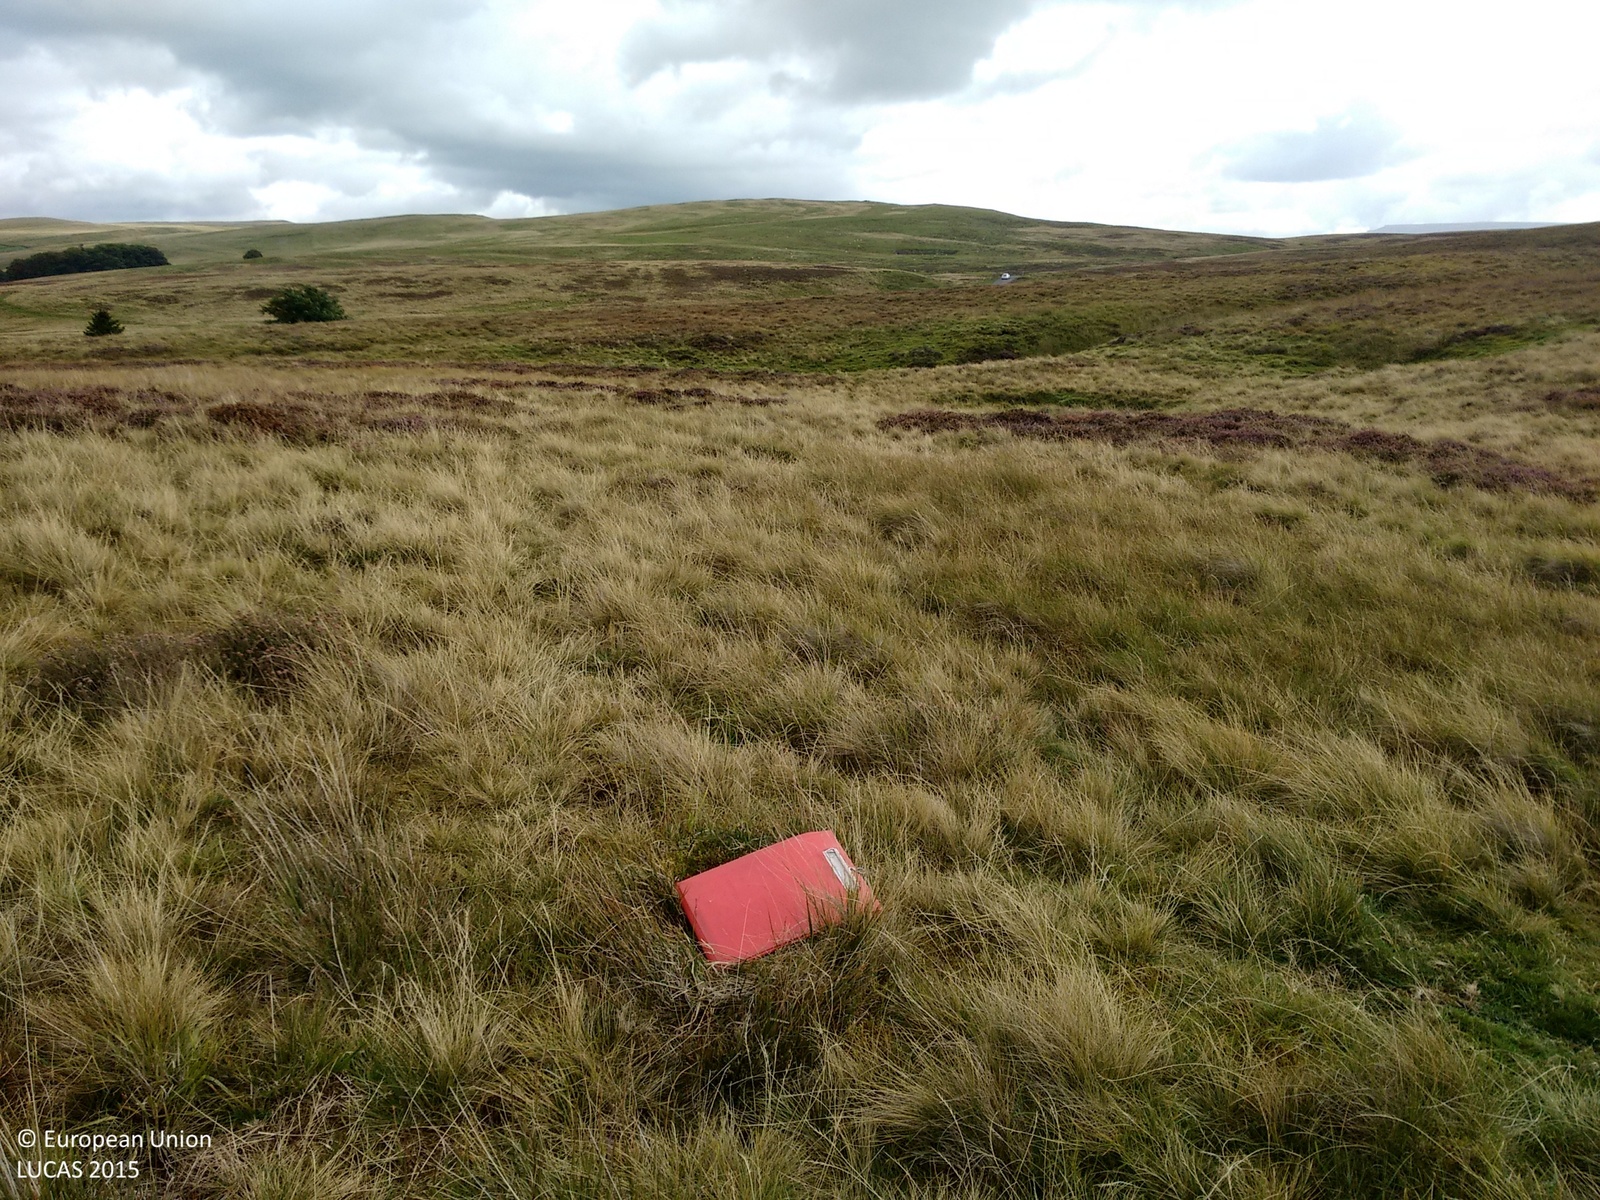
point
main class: Grassland
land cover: Grassland without tree/shrub cover
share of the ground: > 75 %
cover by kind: herbaceous plants 100 %
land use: Agriculture (excluding fallow land and kitchen gardens)
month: September
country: GB
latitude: 54.4642
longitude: -2.4830
